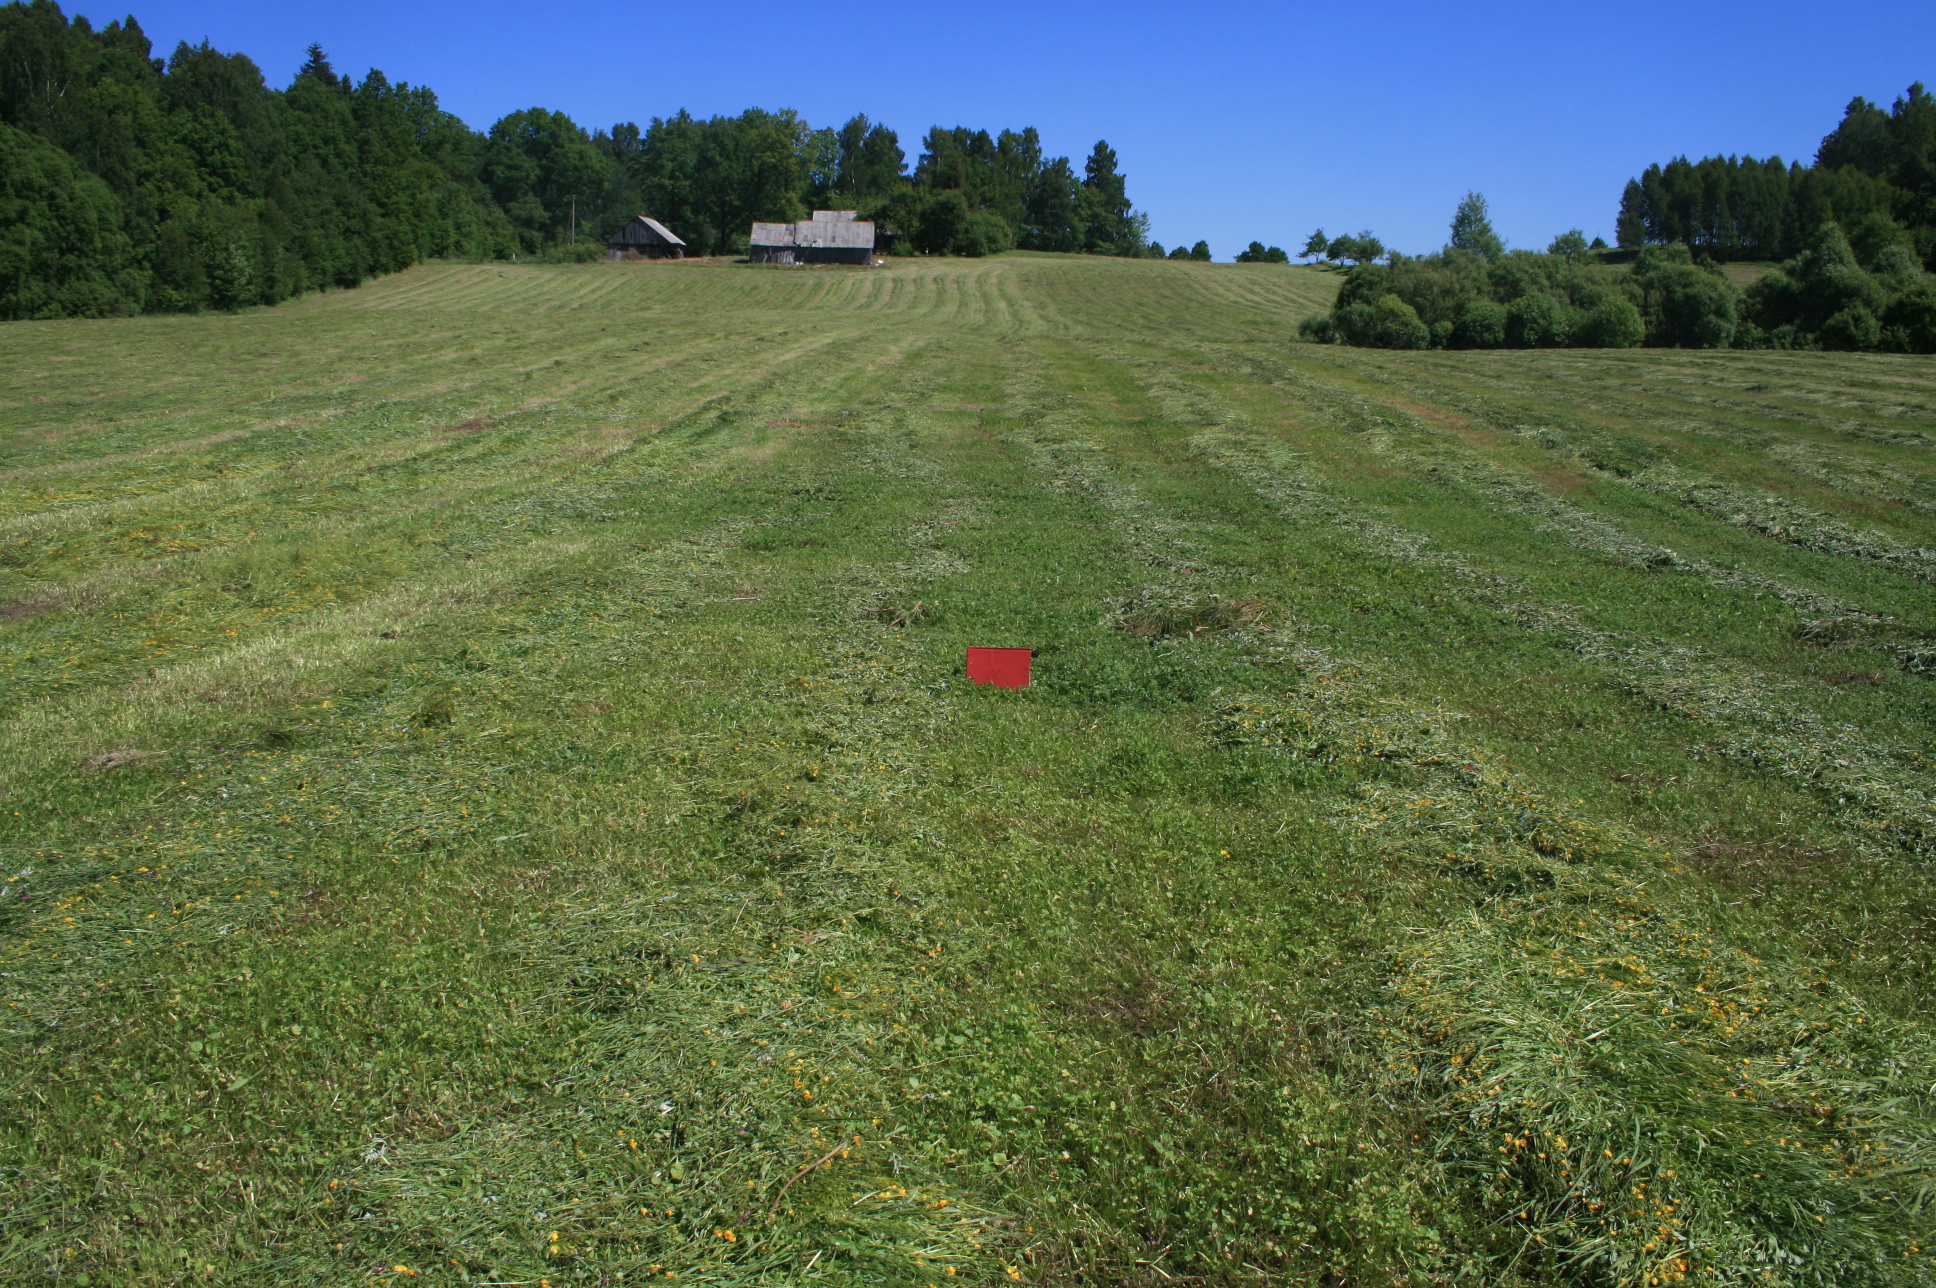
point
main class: Grassland
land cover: Grassland without tree/shrub cover
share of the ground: > 75 %
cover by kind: herbaceous plants 100 %
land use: Agriculture (excluding fallow land and kitchen gardens)
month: June
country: LT
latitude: 55.5769
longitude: 22.0932
